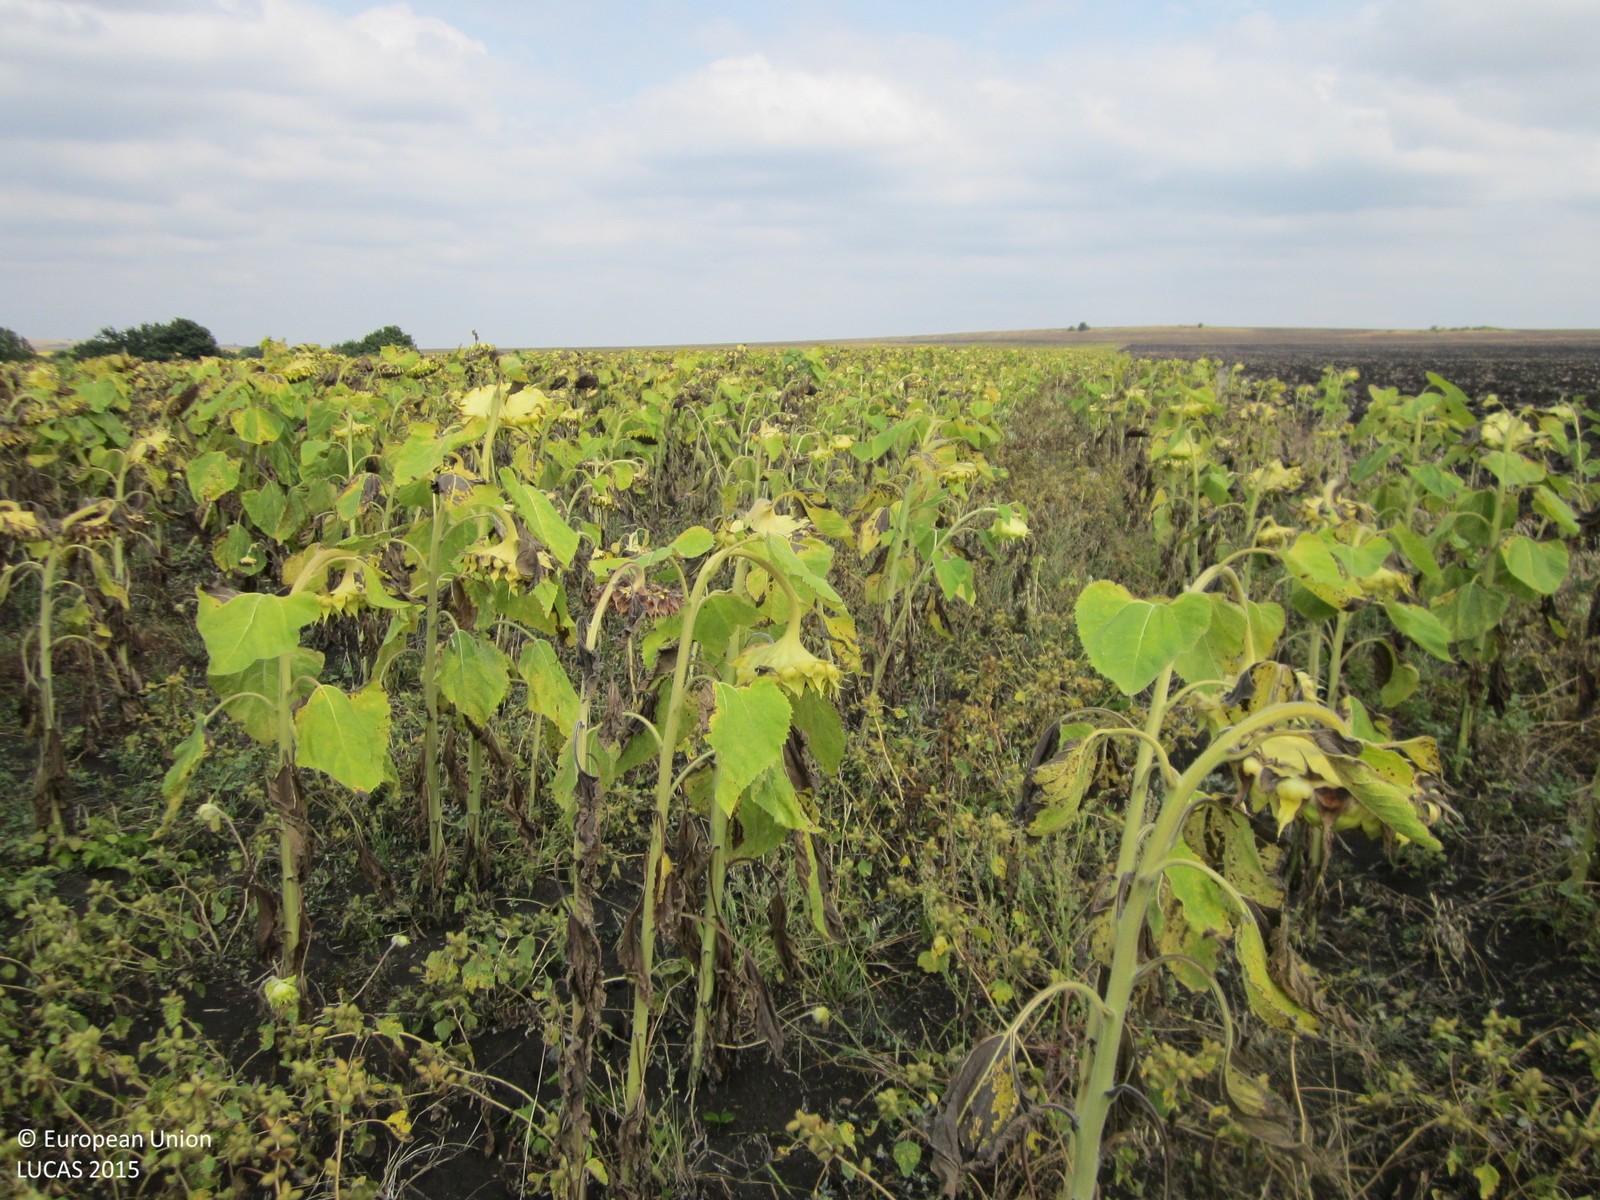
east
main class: Cropland
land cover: Sunflower
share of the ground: > 75 %
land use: Agriculture (excluding fallow land and kitchen gardens)
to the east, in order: Sunflower; Grass margins; Shrubland with sparse tree cover; Rivers and streams; Shrubland with sparse tree cover; Grass margins; Sunflower
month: August
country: BG
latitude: 42.5304
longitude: 26.8908
